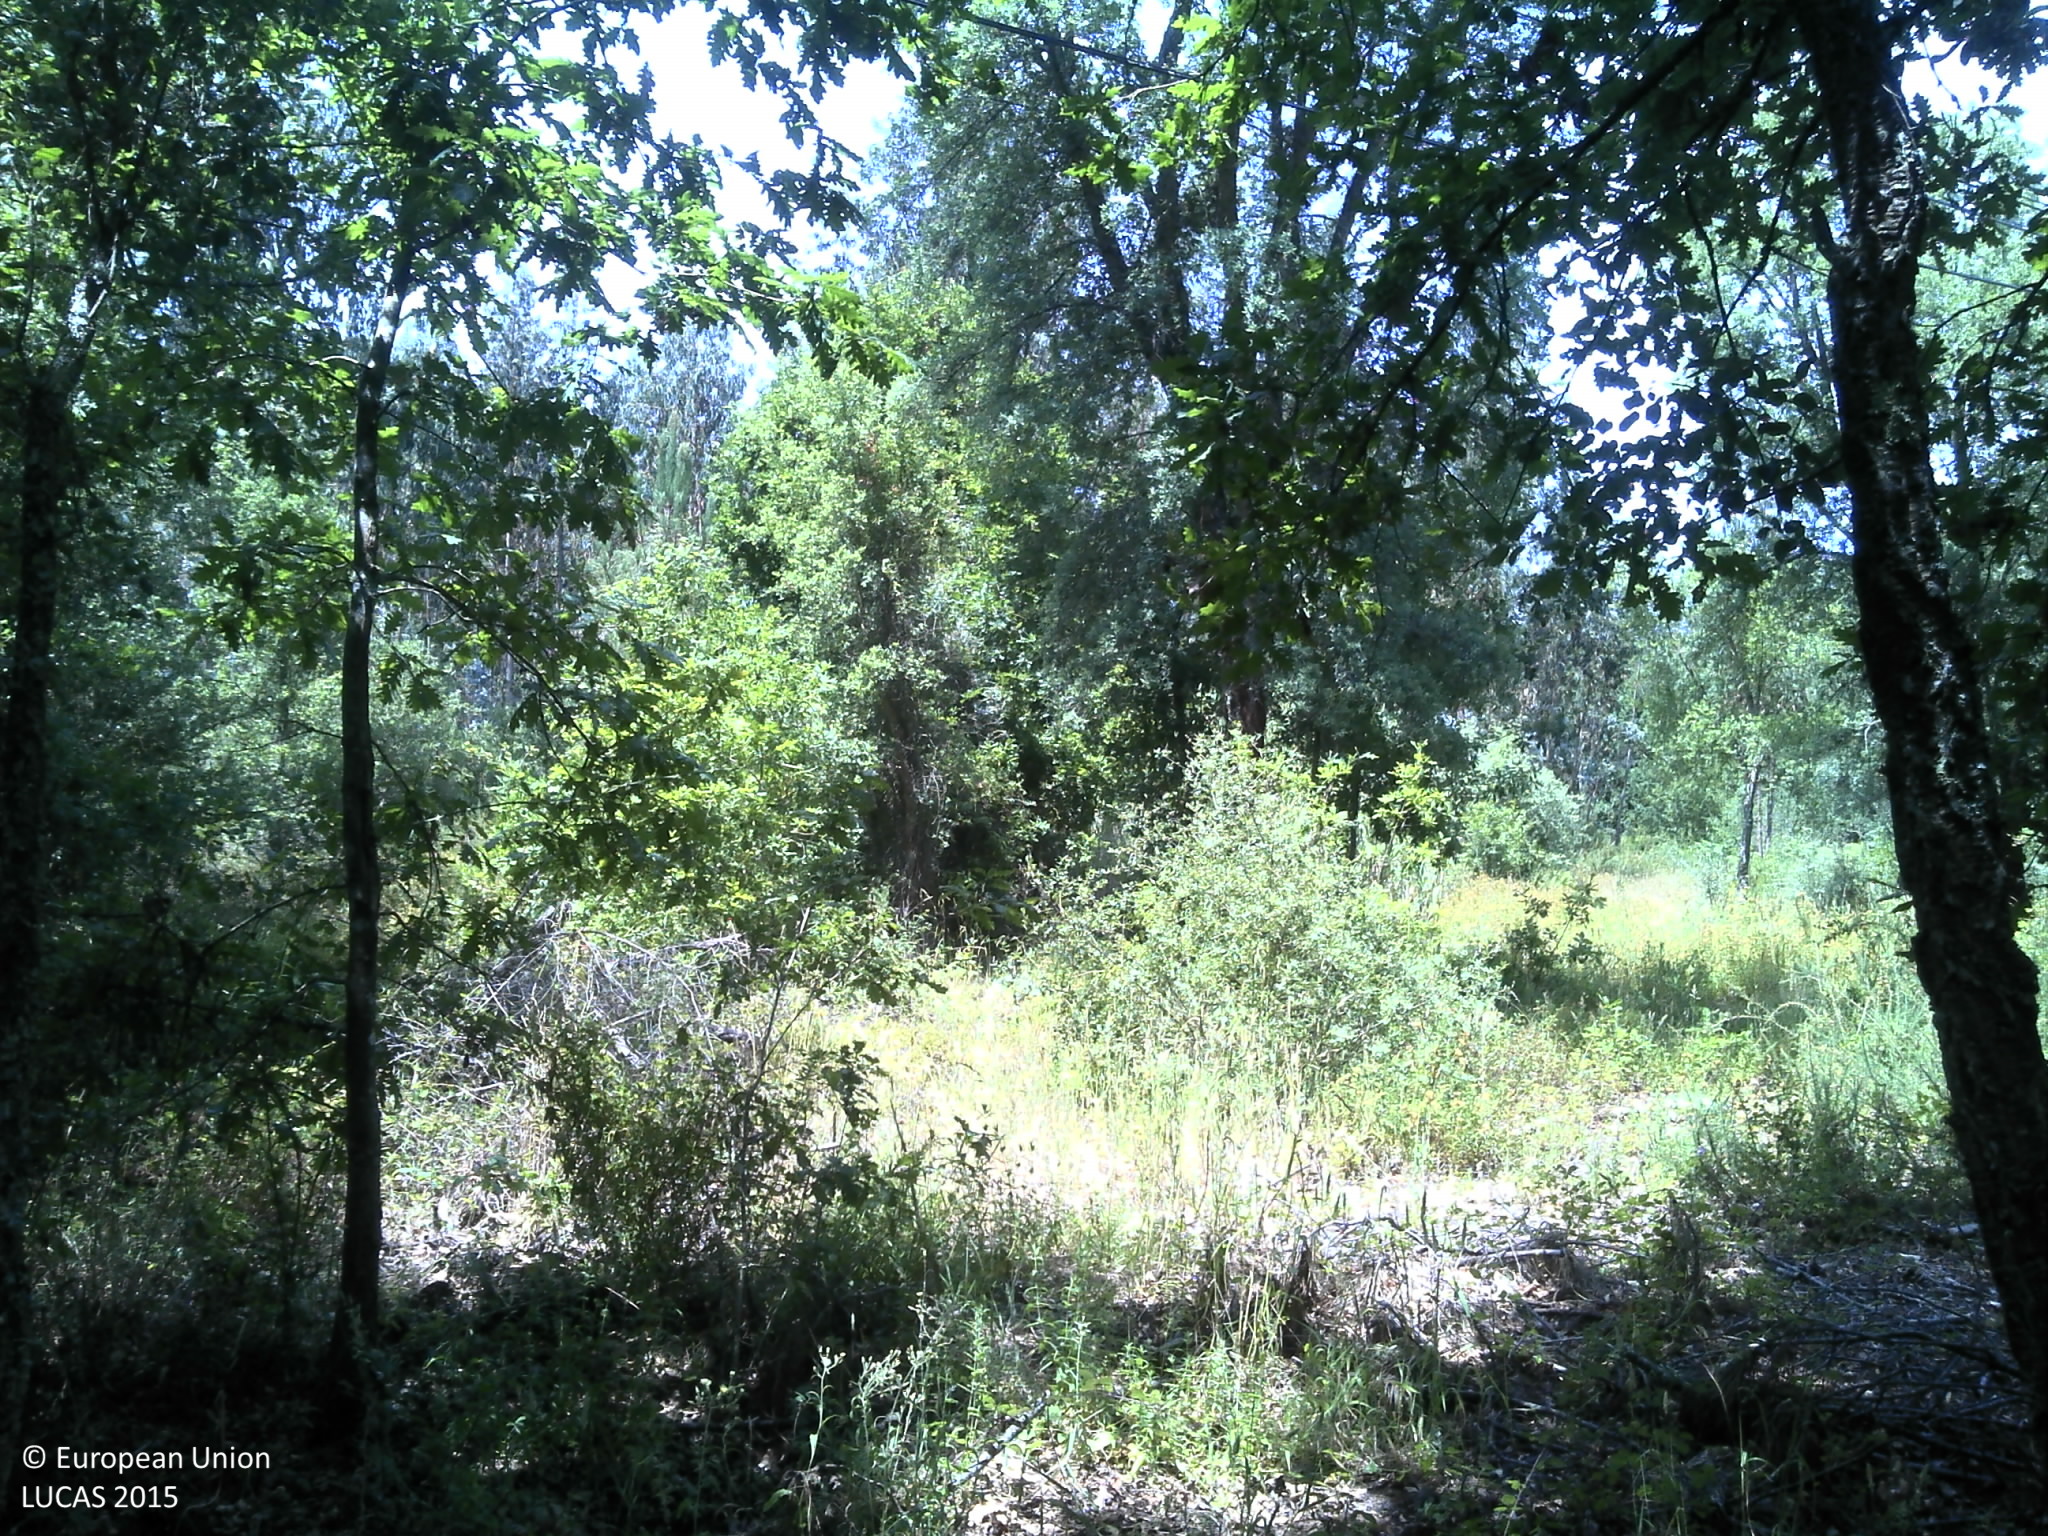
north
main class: Woodland
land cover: Broadleaved woodland
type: thermophilous deciduous forest
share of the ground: 50 - 75 %
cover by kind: broadleaved forest trees 75 %, unconsolidated bare surface 15 %, shrubs 10 %
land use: Semi-natural and natural areas not in use
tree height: > 5 m
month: July
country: PT
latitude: 40.2244
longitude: -8.2350
